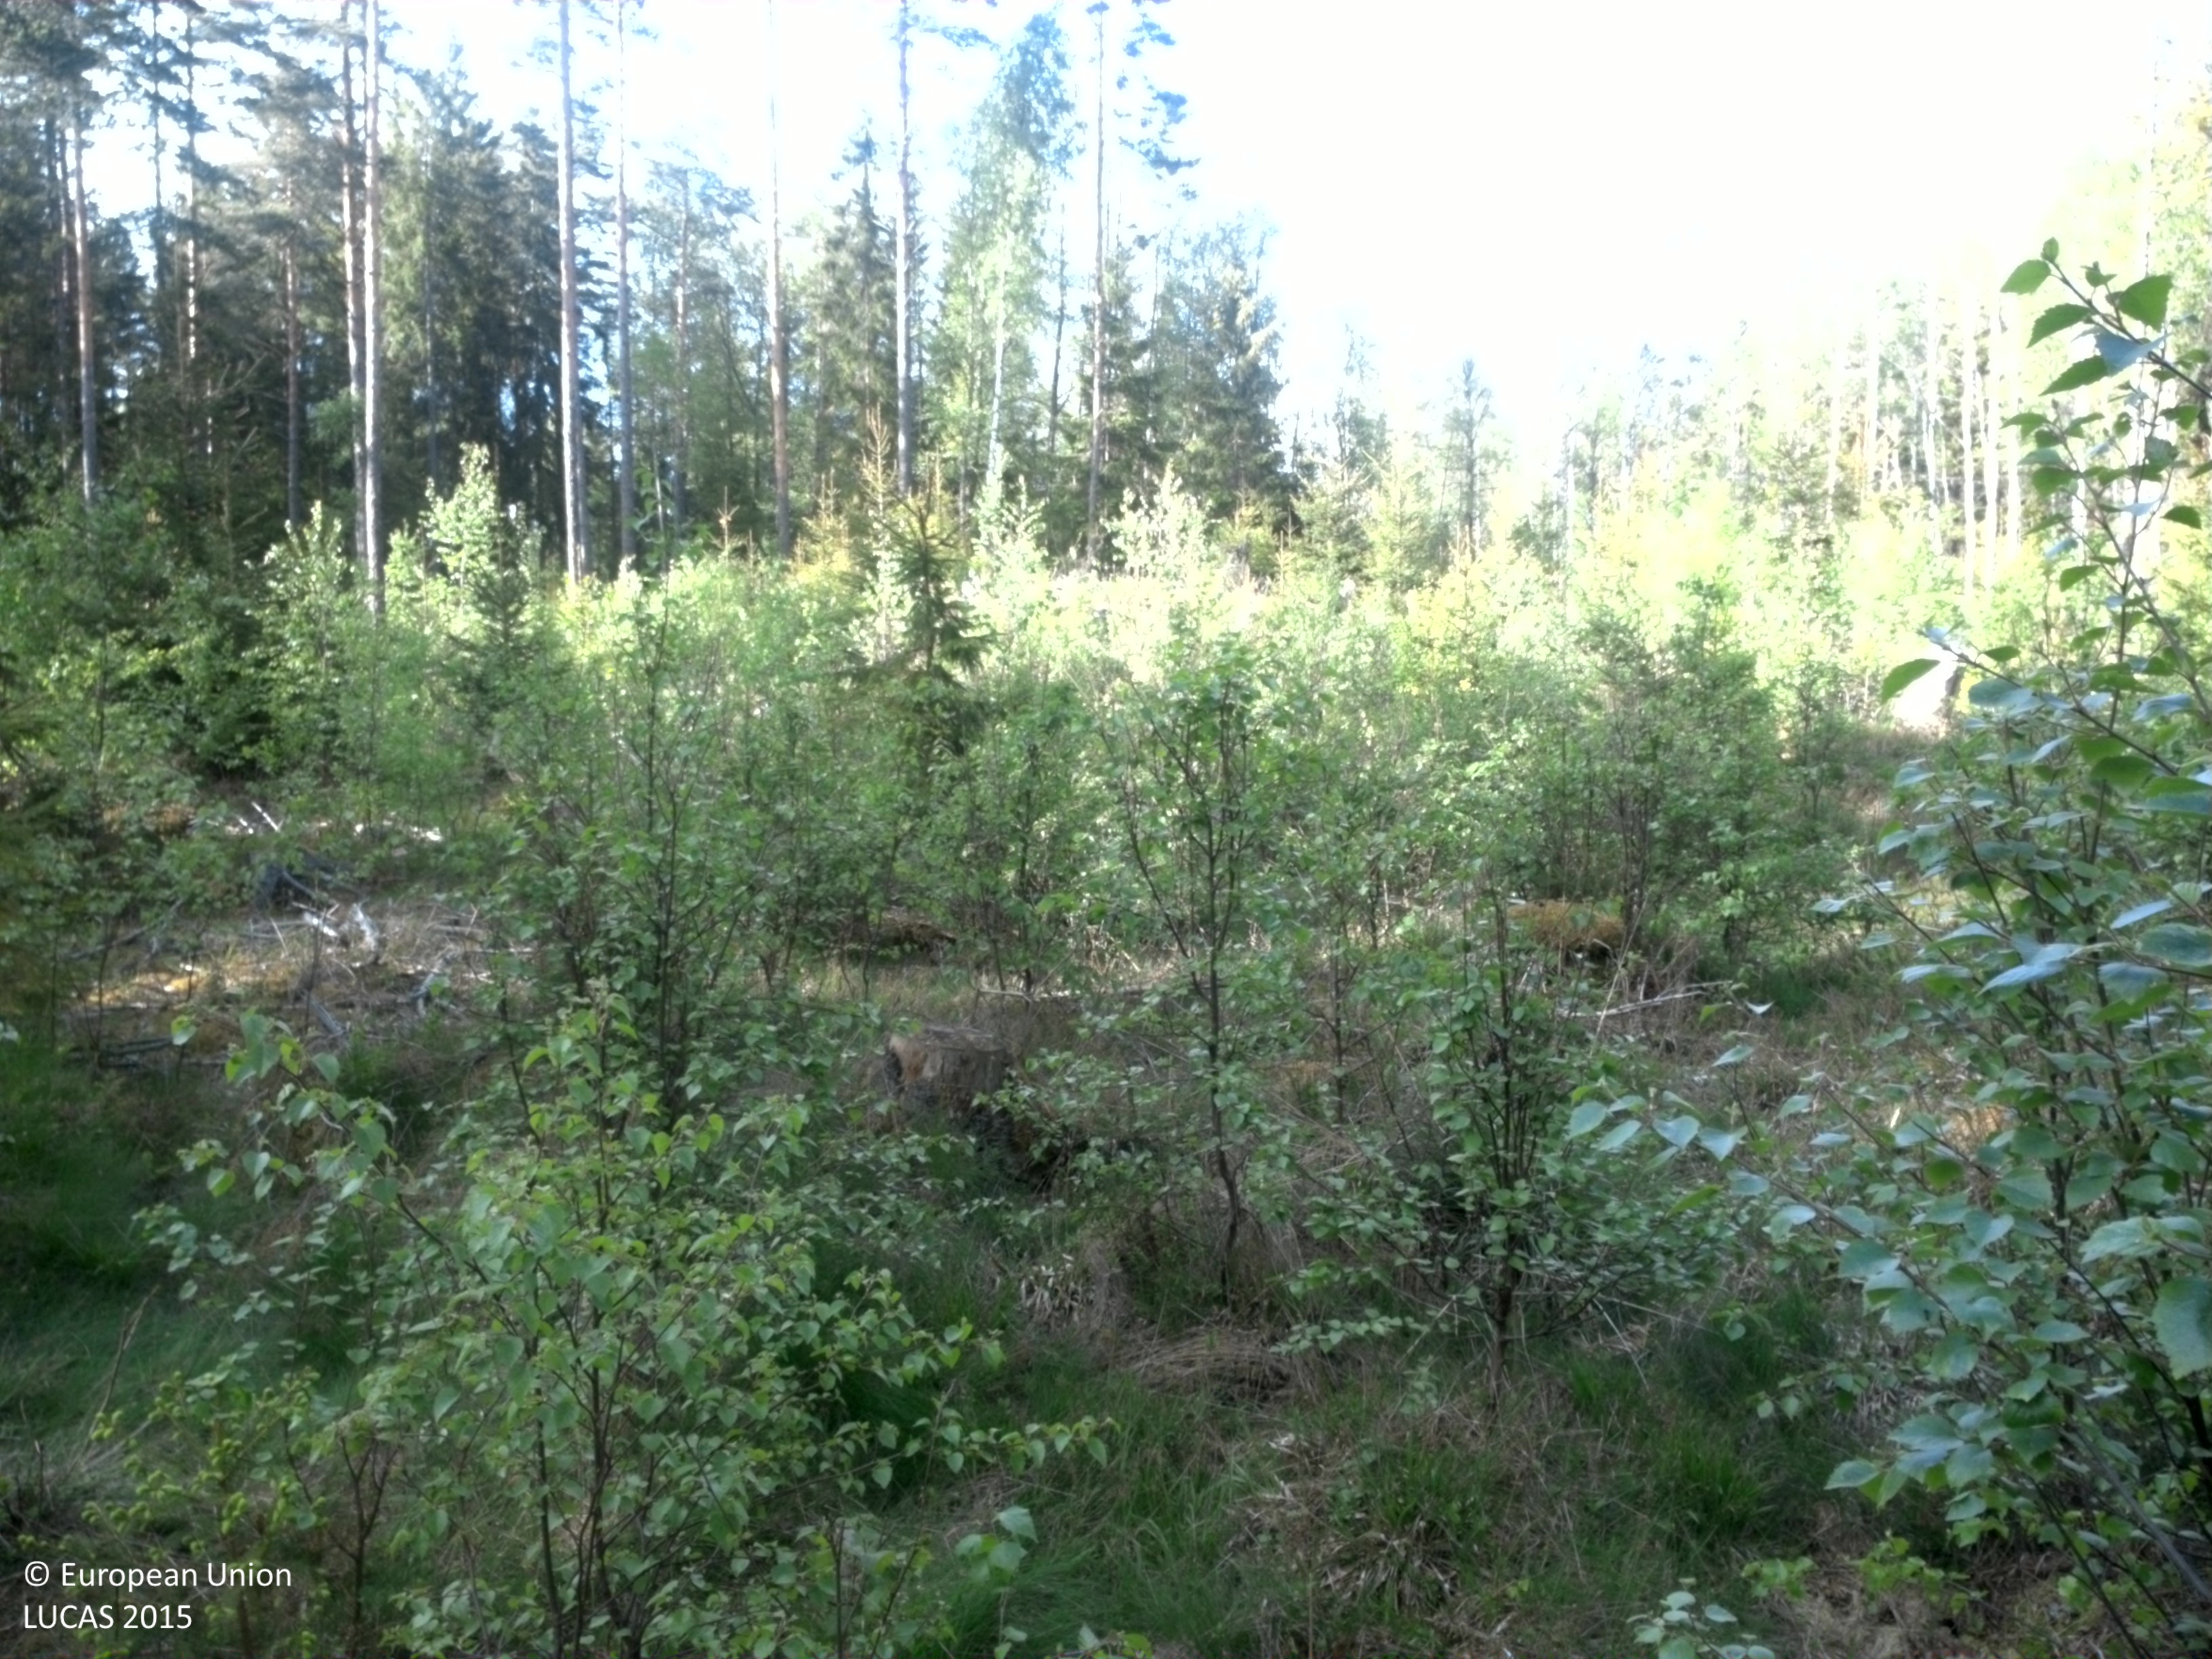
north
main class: Woodland
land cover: Spruce dominated mixed woodland
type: boreal forest
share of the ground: 25 - 50 %
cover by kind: coniferous forest trees 25 %, broadleaved forest trees 25 %, shrubs 20 %, herbaceous plants 20 %, lichens and mosses 10 %
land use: Forestry
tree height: > 5 m
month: May
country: SE
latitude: 57.3103
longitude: 15.9913
